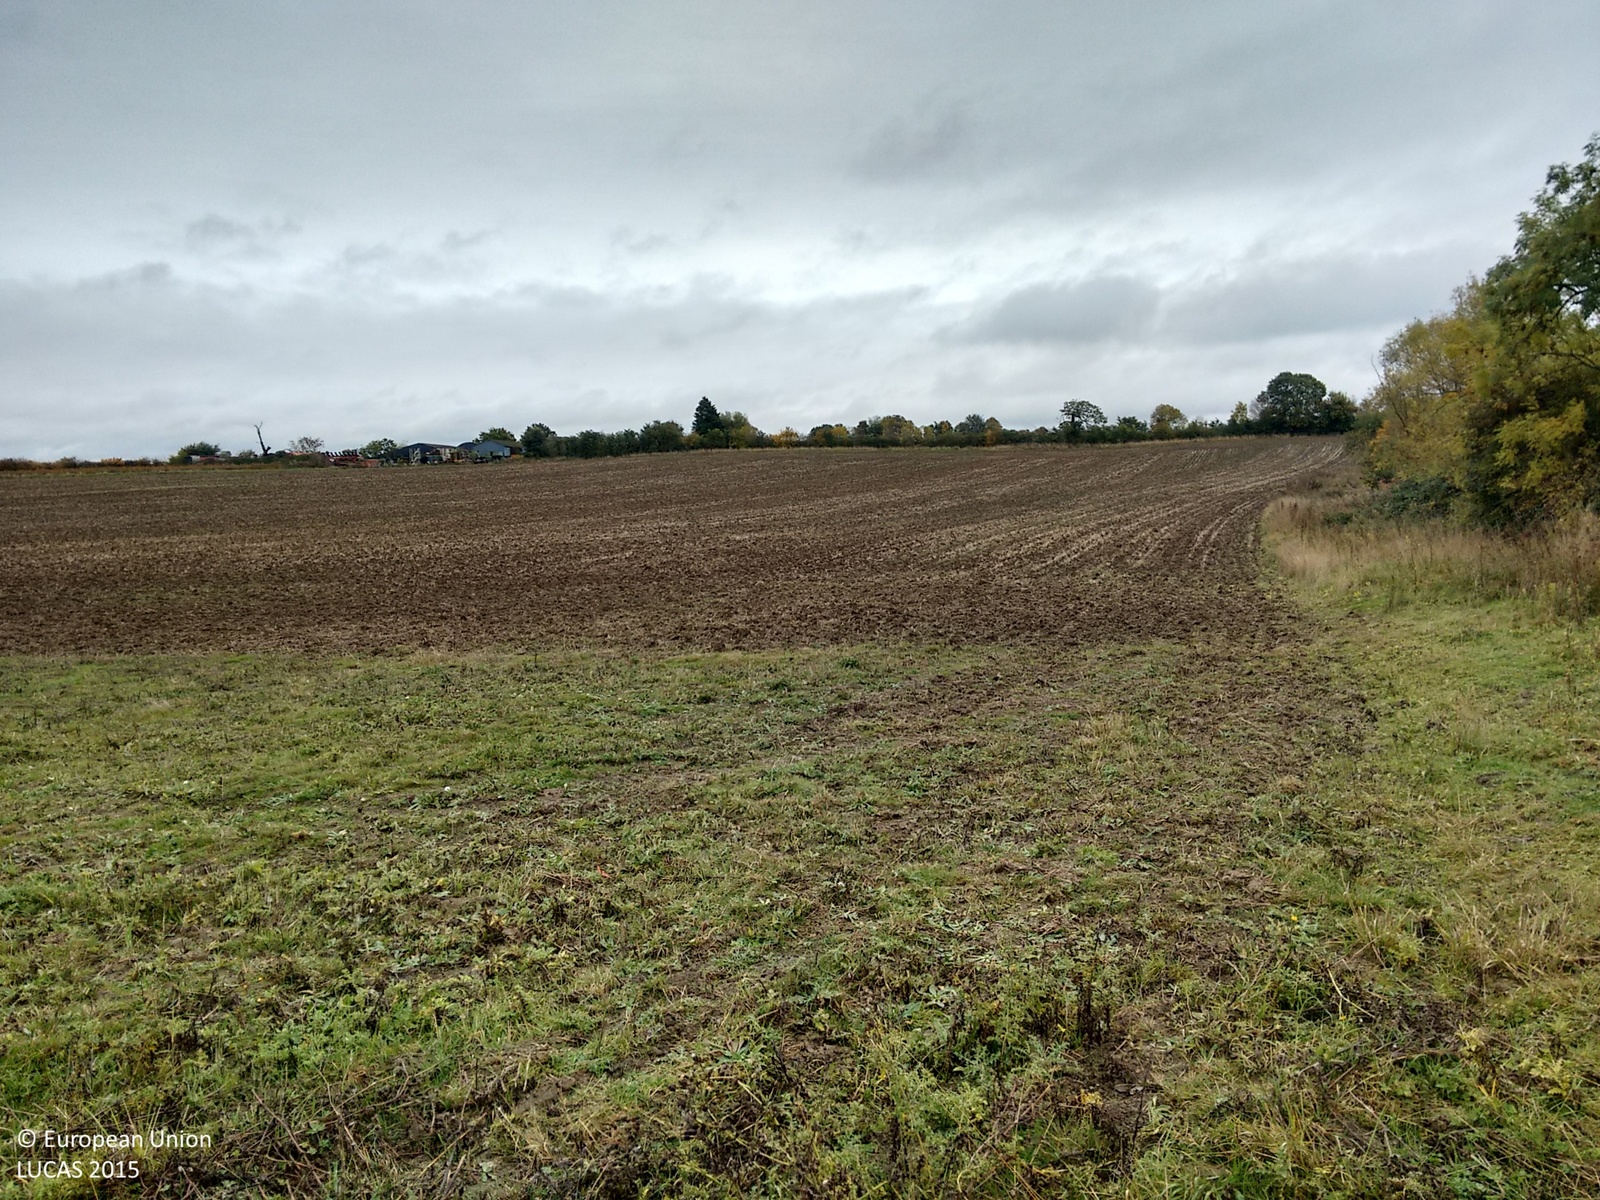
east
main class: Grassland
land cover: Grassland without tree/shrub cover
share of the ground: > 75 %
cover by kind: herbaceous plants 100 %
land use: Agriculture (excluding fallow land and kitchen gardens)
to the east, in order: Grassland without tree/shrub cover; Other bare soil; Grass margins; Managed hedges; Ditches and canals; Grass margins; Tracks; Managed hedges; Grass margins
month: October
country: GB
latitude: 52.0151
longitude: -1.6959
